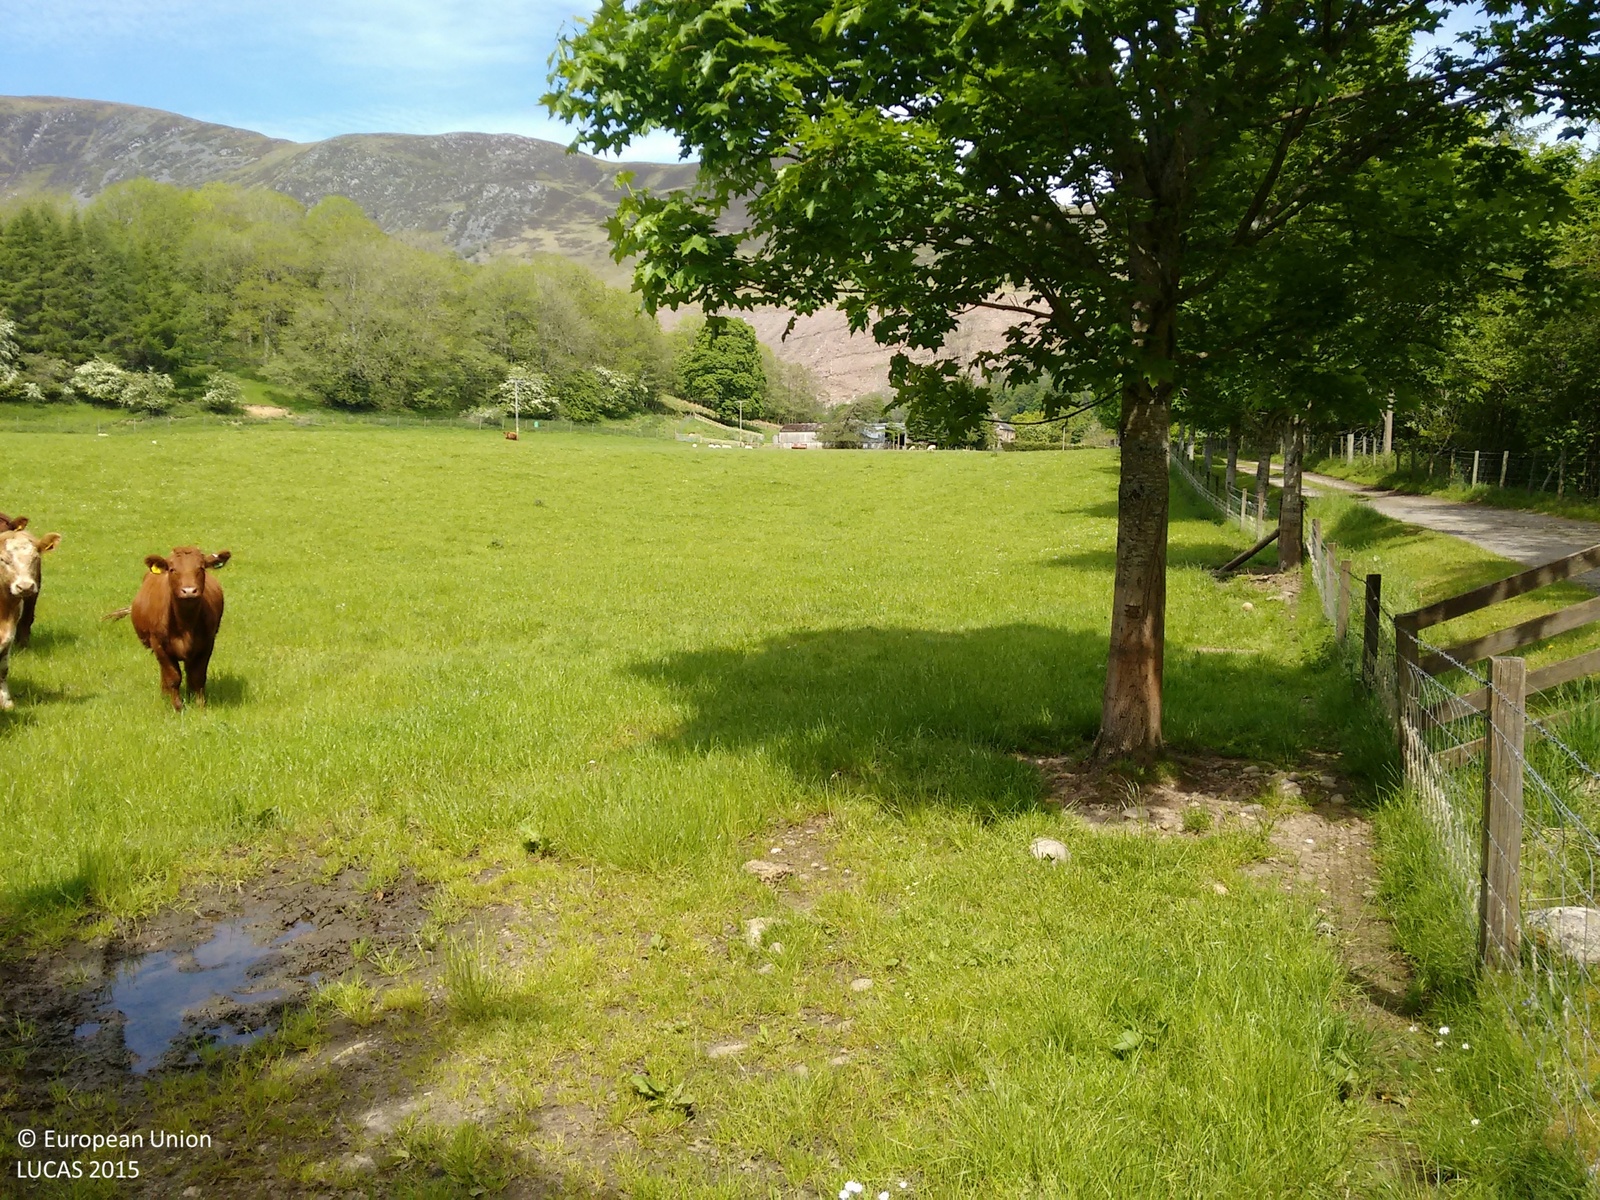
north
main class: Grassland
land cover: Grassland without tree/shrub cover
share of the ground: > 75 %
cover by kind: herbaceous plants 100 %
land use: Agriculture (excluding fallow land and kitchen gardens)
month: June
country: GB
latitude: 56.5951
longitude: -4.0761
